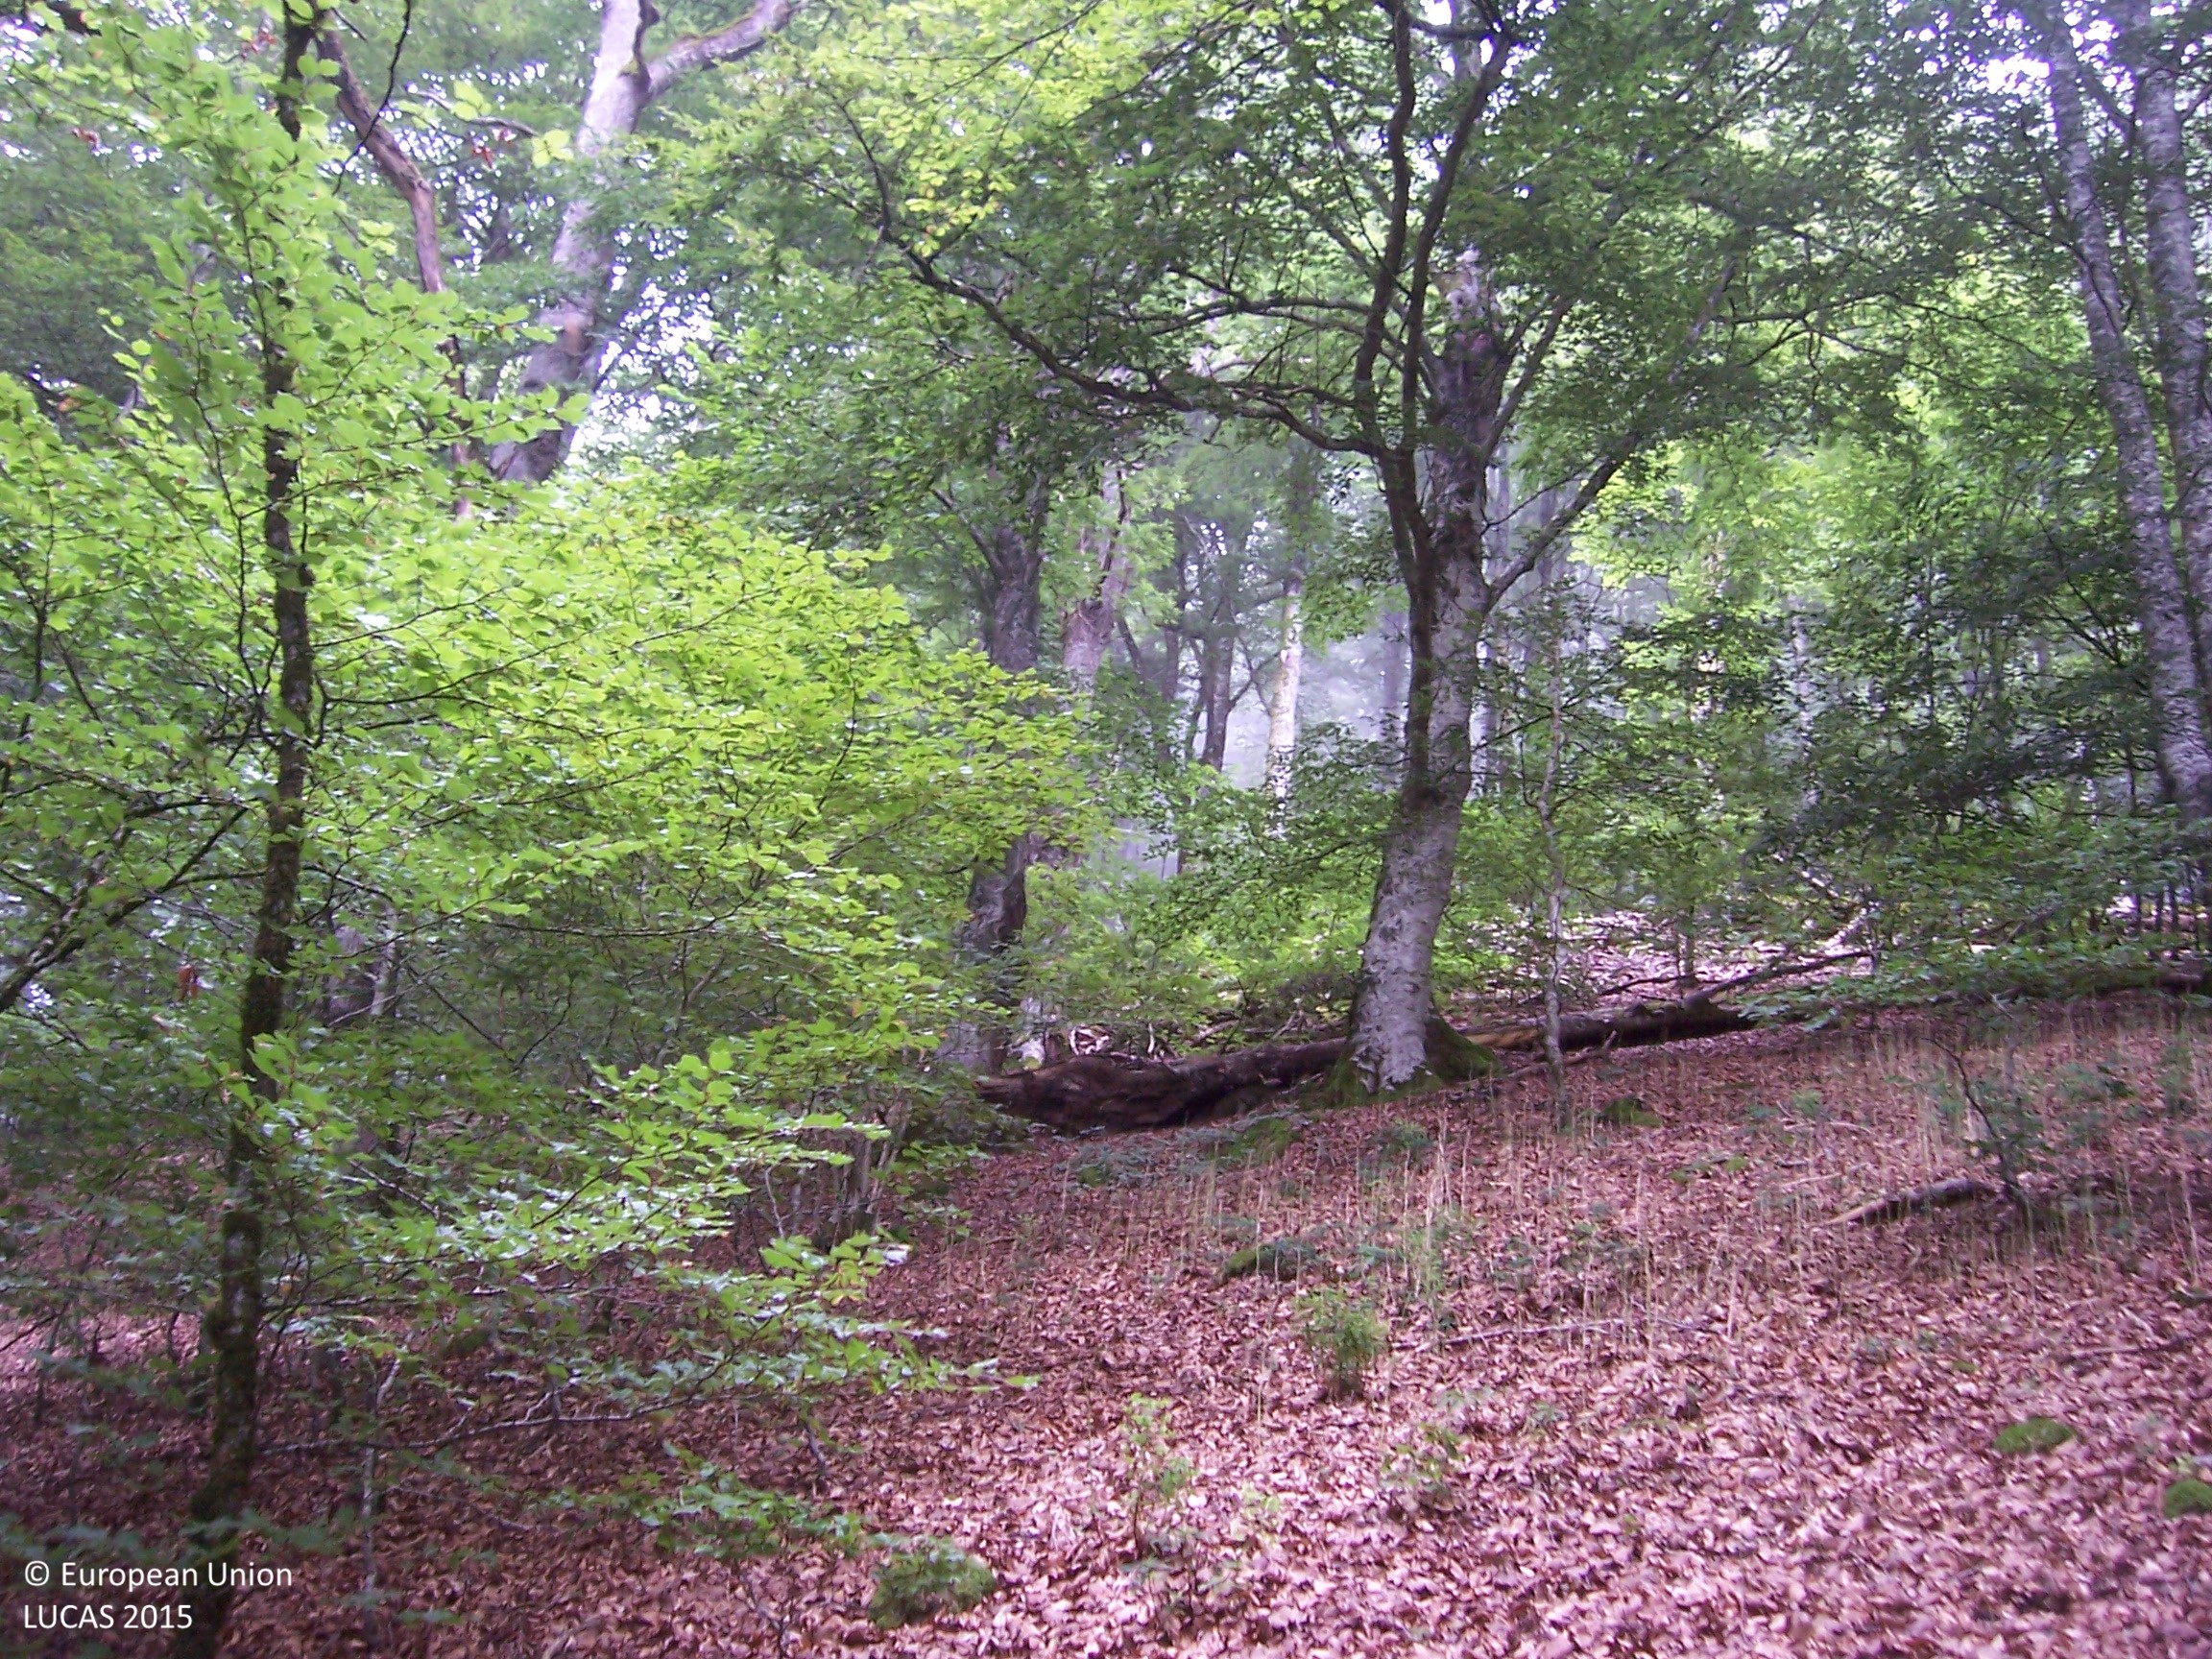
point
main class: Woodland
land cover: Broadleaved woodland
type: mountainous beech forest
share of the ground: > 75 %
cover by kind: broadleaved forest trees 100 %
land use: Forestry
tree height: > 5 m
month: July
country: ES
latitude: 43.0127
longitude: -1.2138
